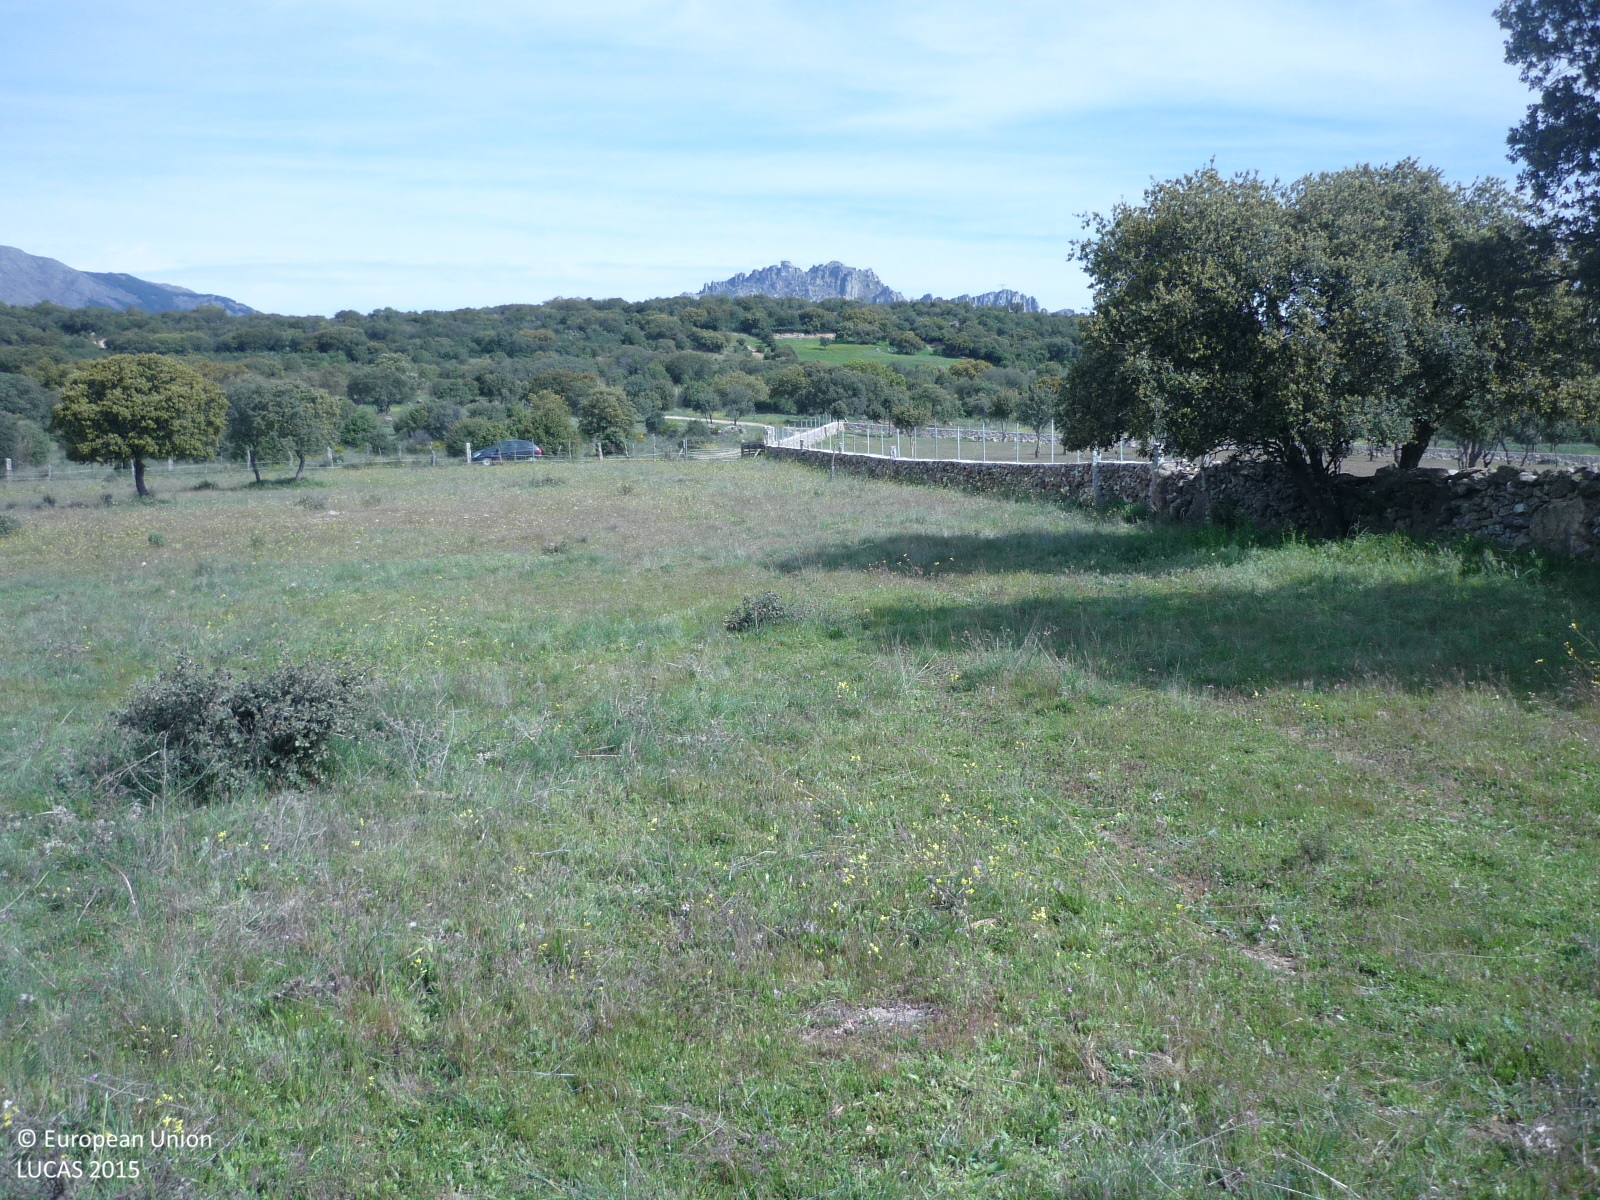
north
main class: Grassland
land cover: Grassland with sparse tree/shrub cover
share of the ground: > 75 %
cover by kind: herbaceous plants 85 %, shrubs 10 %, broadleaved forest trees 5 %
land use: Agriculture (excluding fallow land and kitchen gardens)
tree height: < 5 m
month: April
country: ES
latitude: 40.8294
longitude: -3.6431
